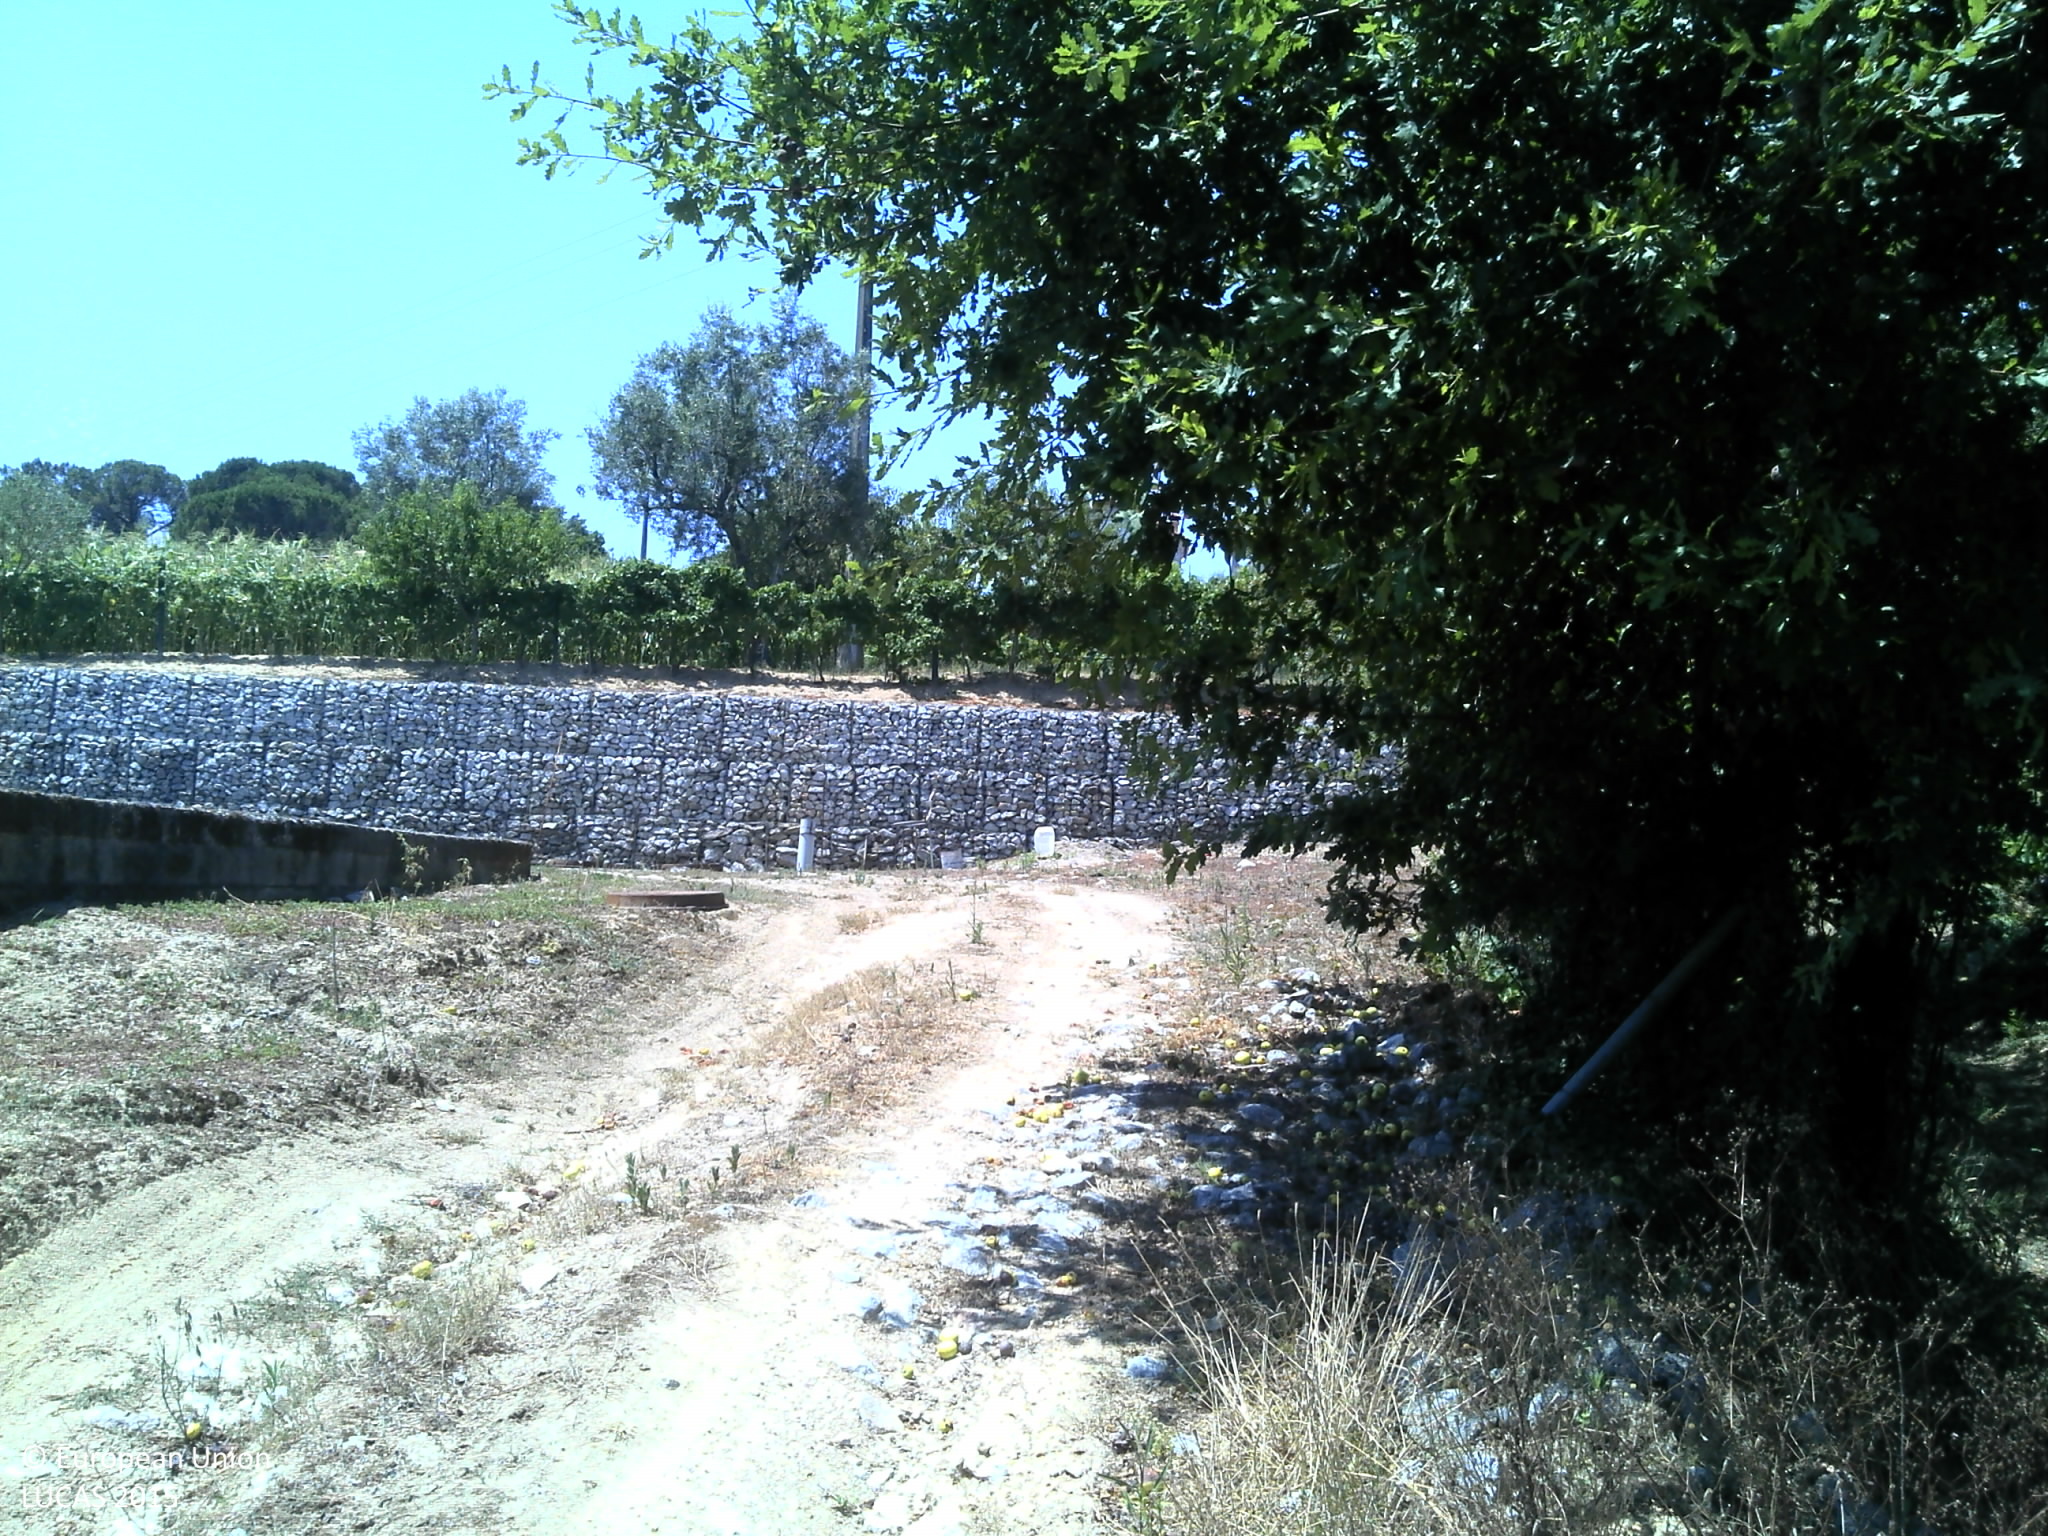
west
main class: Cropland
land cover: Vineyards
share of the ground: < 10 %
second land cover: Grassland without tree/shrub cover
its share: 25 - 50 %
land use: Agriculture (excluding fallow land and kitchen gardens)
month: July
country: PT
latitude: 40.4380
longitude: -7.9826
